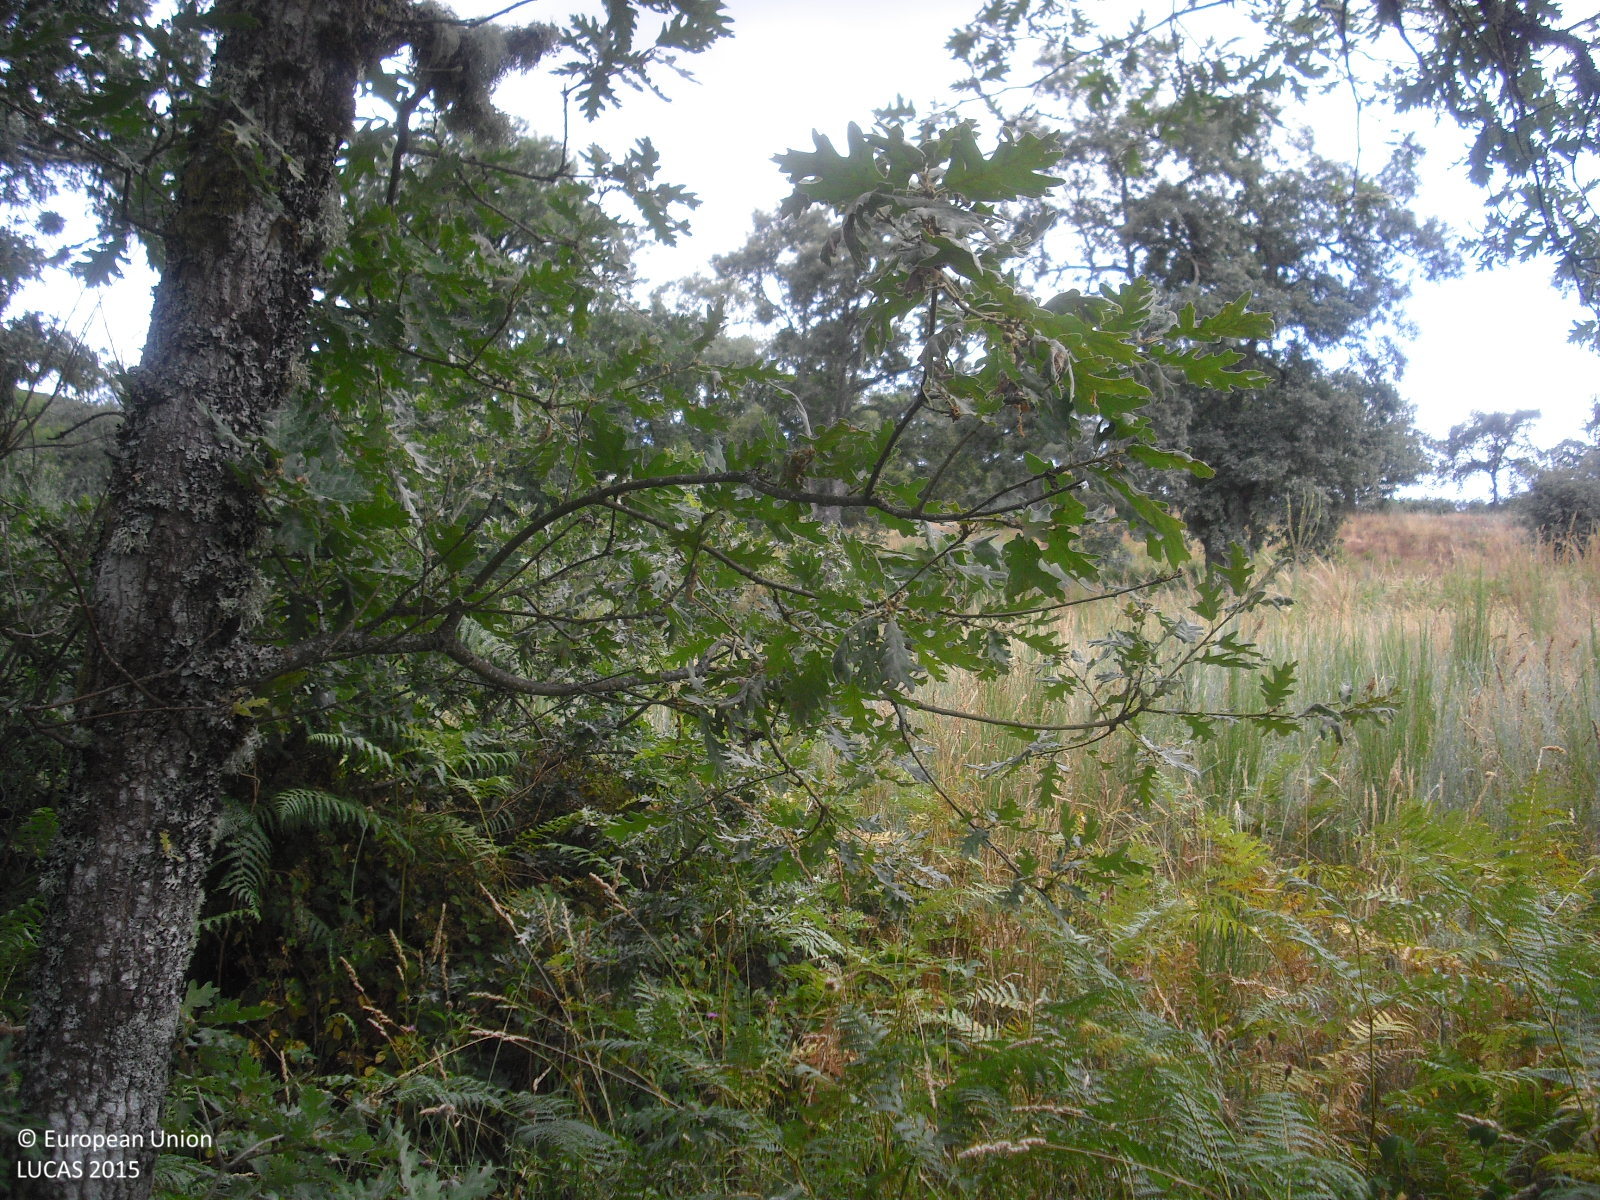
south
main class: Woodland
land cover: Broadleaved woodland
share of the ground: 25 - 50 %
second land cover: Shrubland without tree cover
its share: 50 - 75 %
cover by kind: broadleaved forest trees 50 %, shrubs 50 %
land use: Forestry
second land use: Agriculture (excluding fallow land and kitchen gardens)
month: July
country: ES
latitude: 42.3270
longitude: -7.4303
